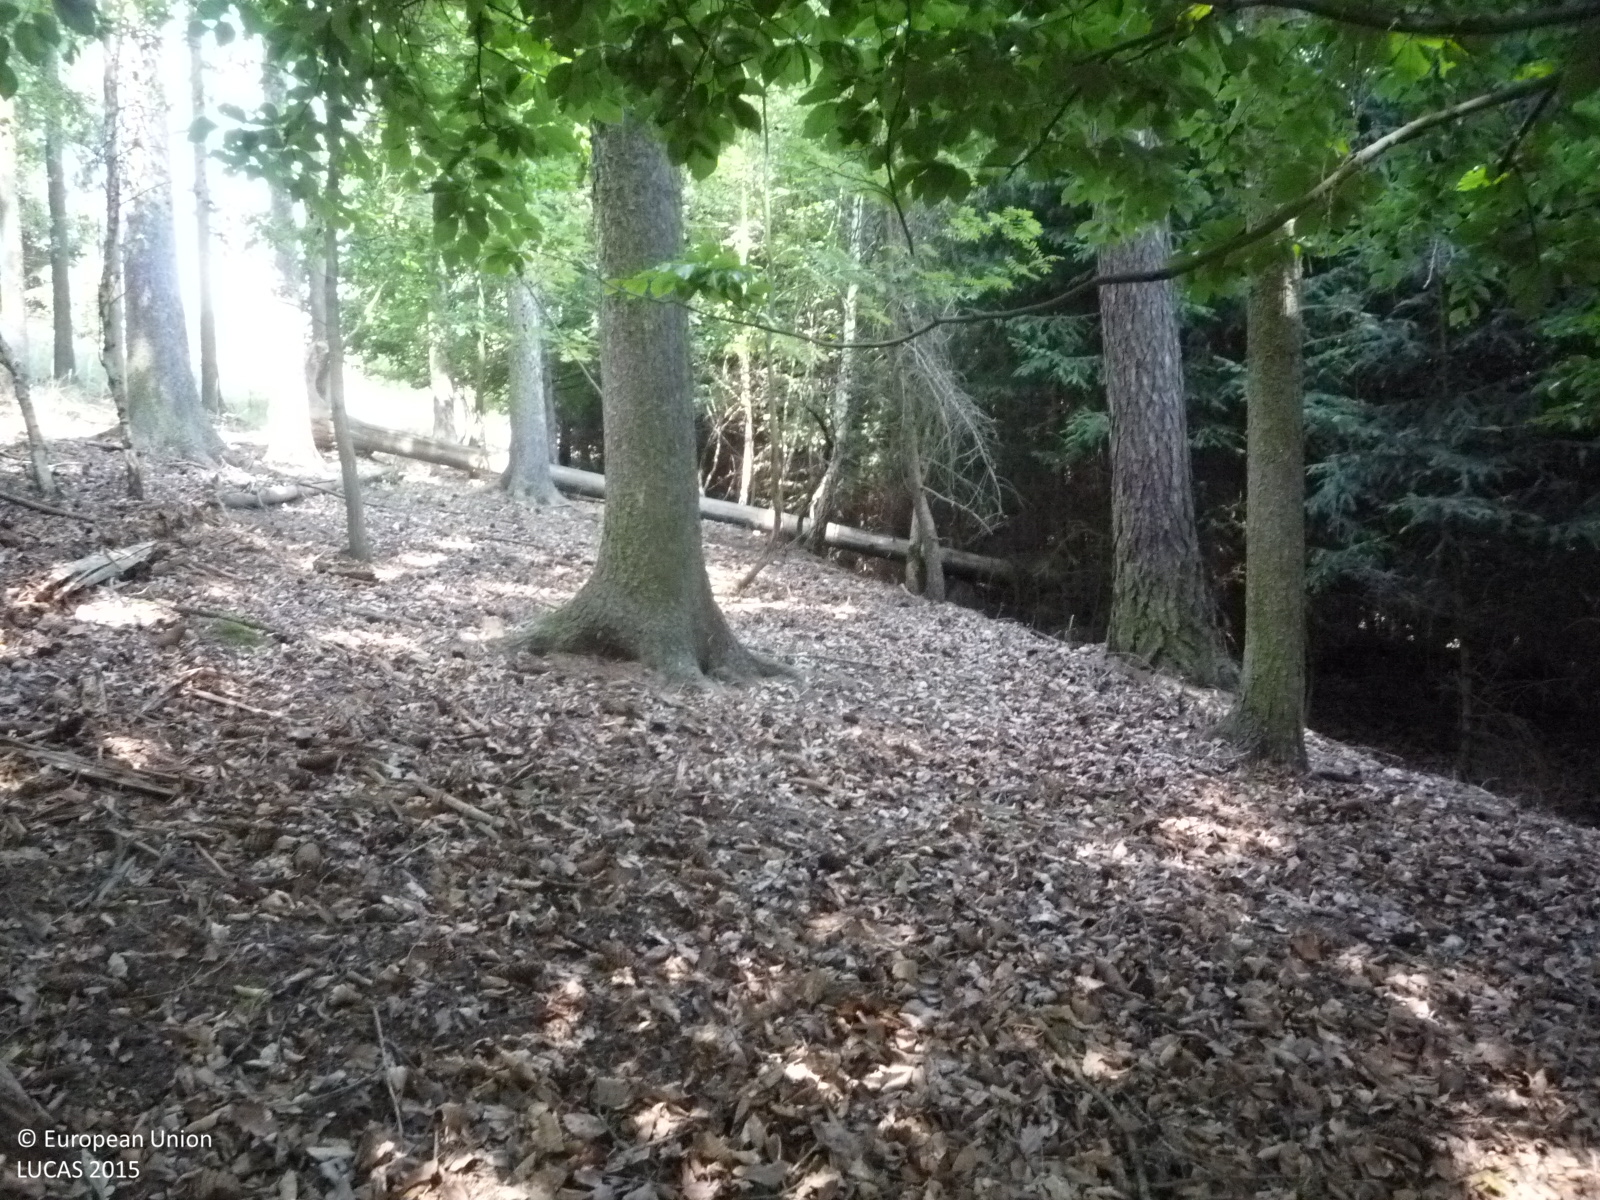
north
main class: Woodland
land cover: Spruce dominated mixed woodland
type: hemiboreal forest and nemoral coniferous forest and mixed broadleaved-coniferous forest
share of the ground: > 75 %
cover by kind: coniferous forest trees 50 %, broadleaved forest trees 40 %, unconsolidated bare surface 10 %
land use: Forestry
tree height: > 5 m
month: August
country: CZ
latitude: 49.8120
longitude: 14.8244
